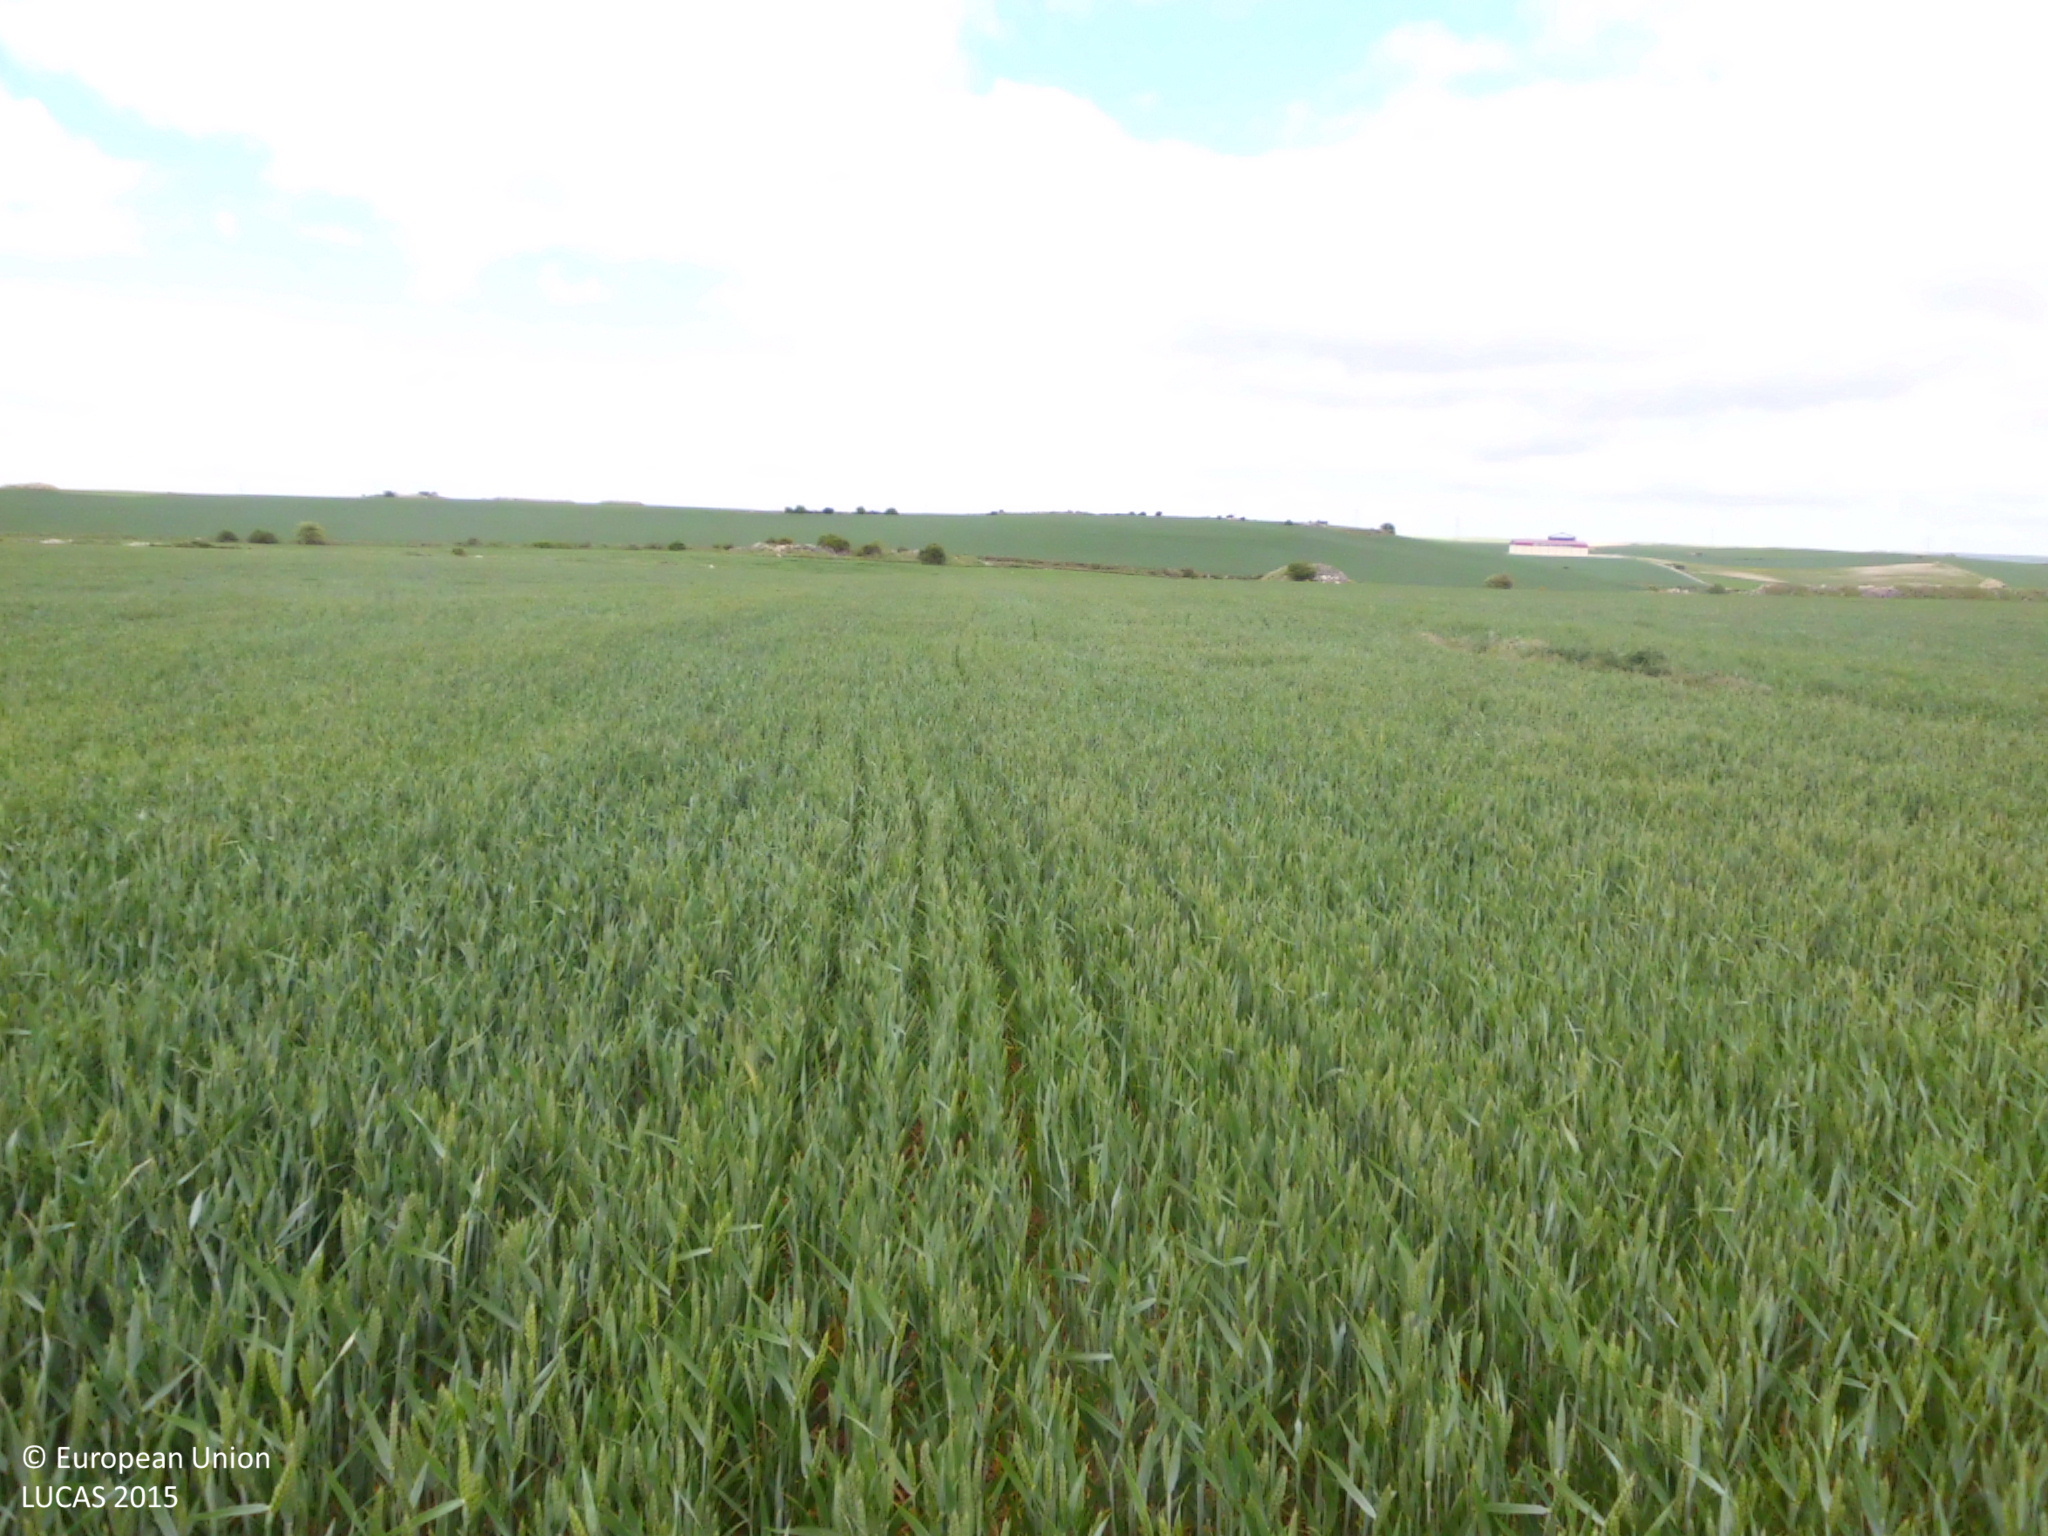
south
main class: Cropland
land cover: Common wheat
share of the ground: > 75 %
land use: Agriculture (excluding fallow land and kitchen gardens)
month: May
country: ES
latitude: 42.3891
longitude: -3.8750
